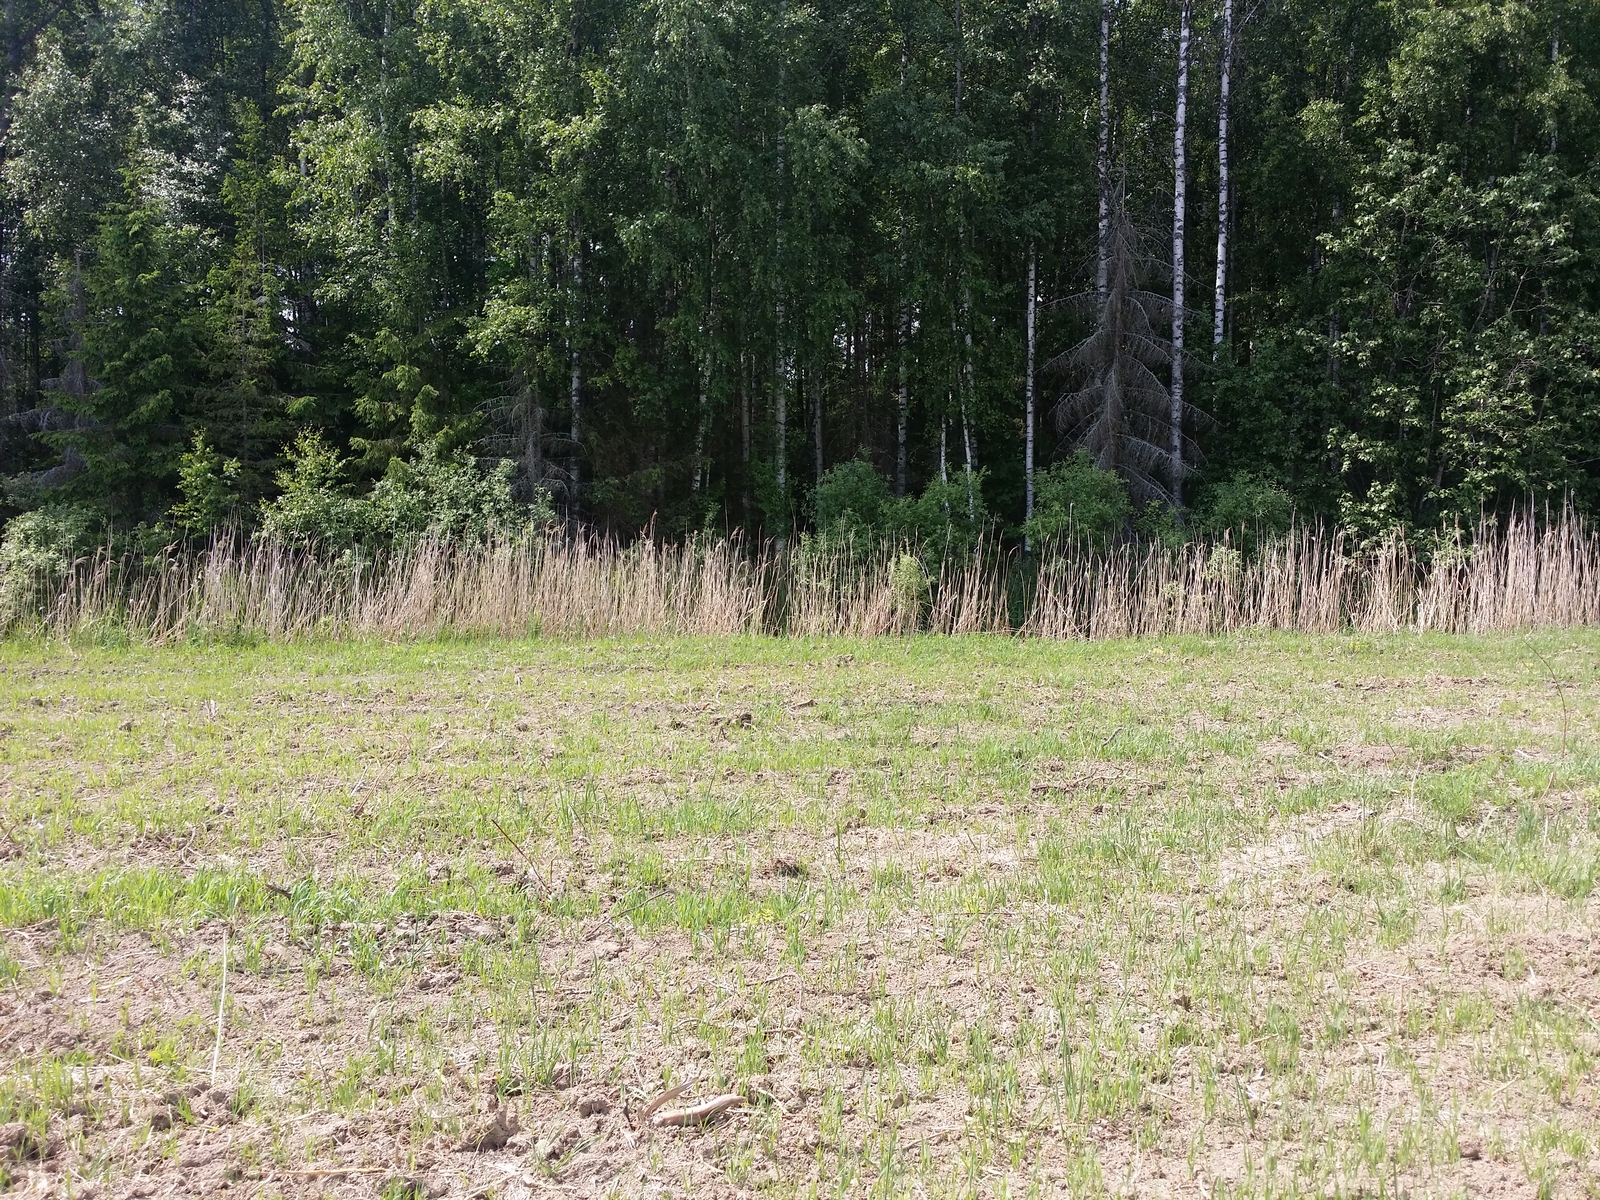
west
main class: Cropland
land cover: Oats
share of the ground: 10 - 25 %
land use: Agriculture (excluding fallow land and kitchen gardens)
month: June
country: LV
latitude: 57.4437
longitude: 26.5219
